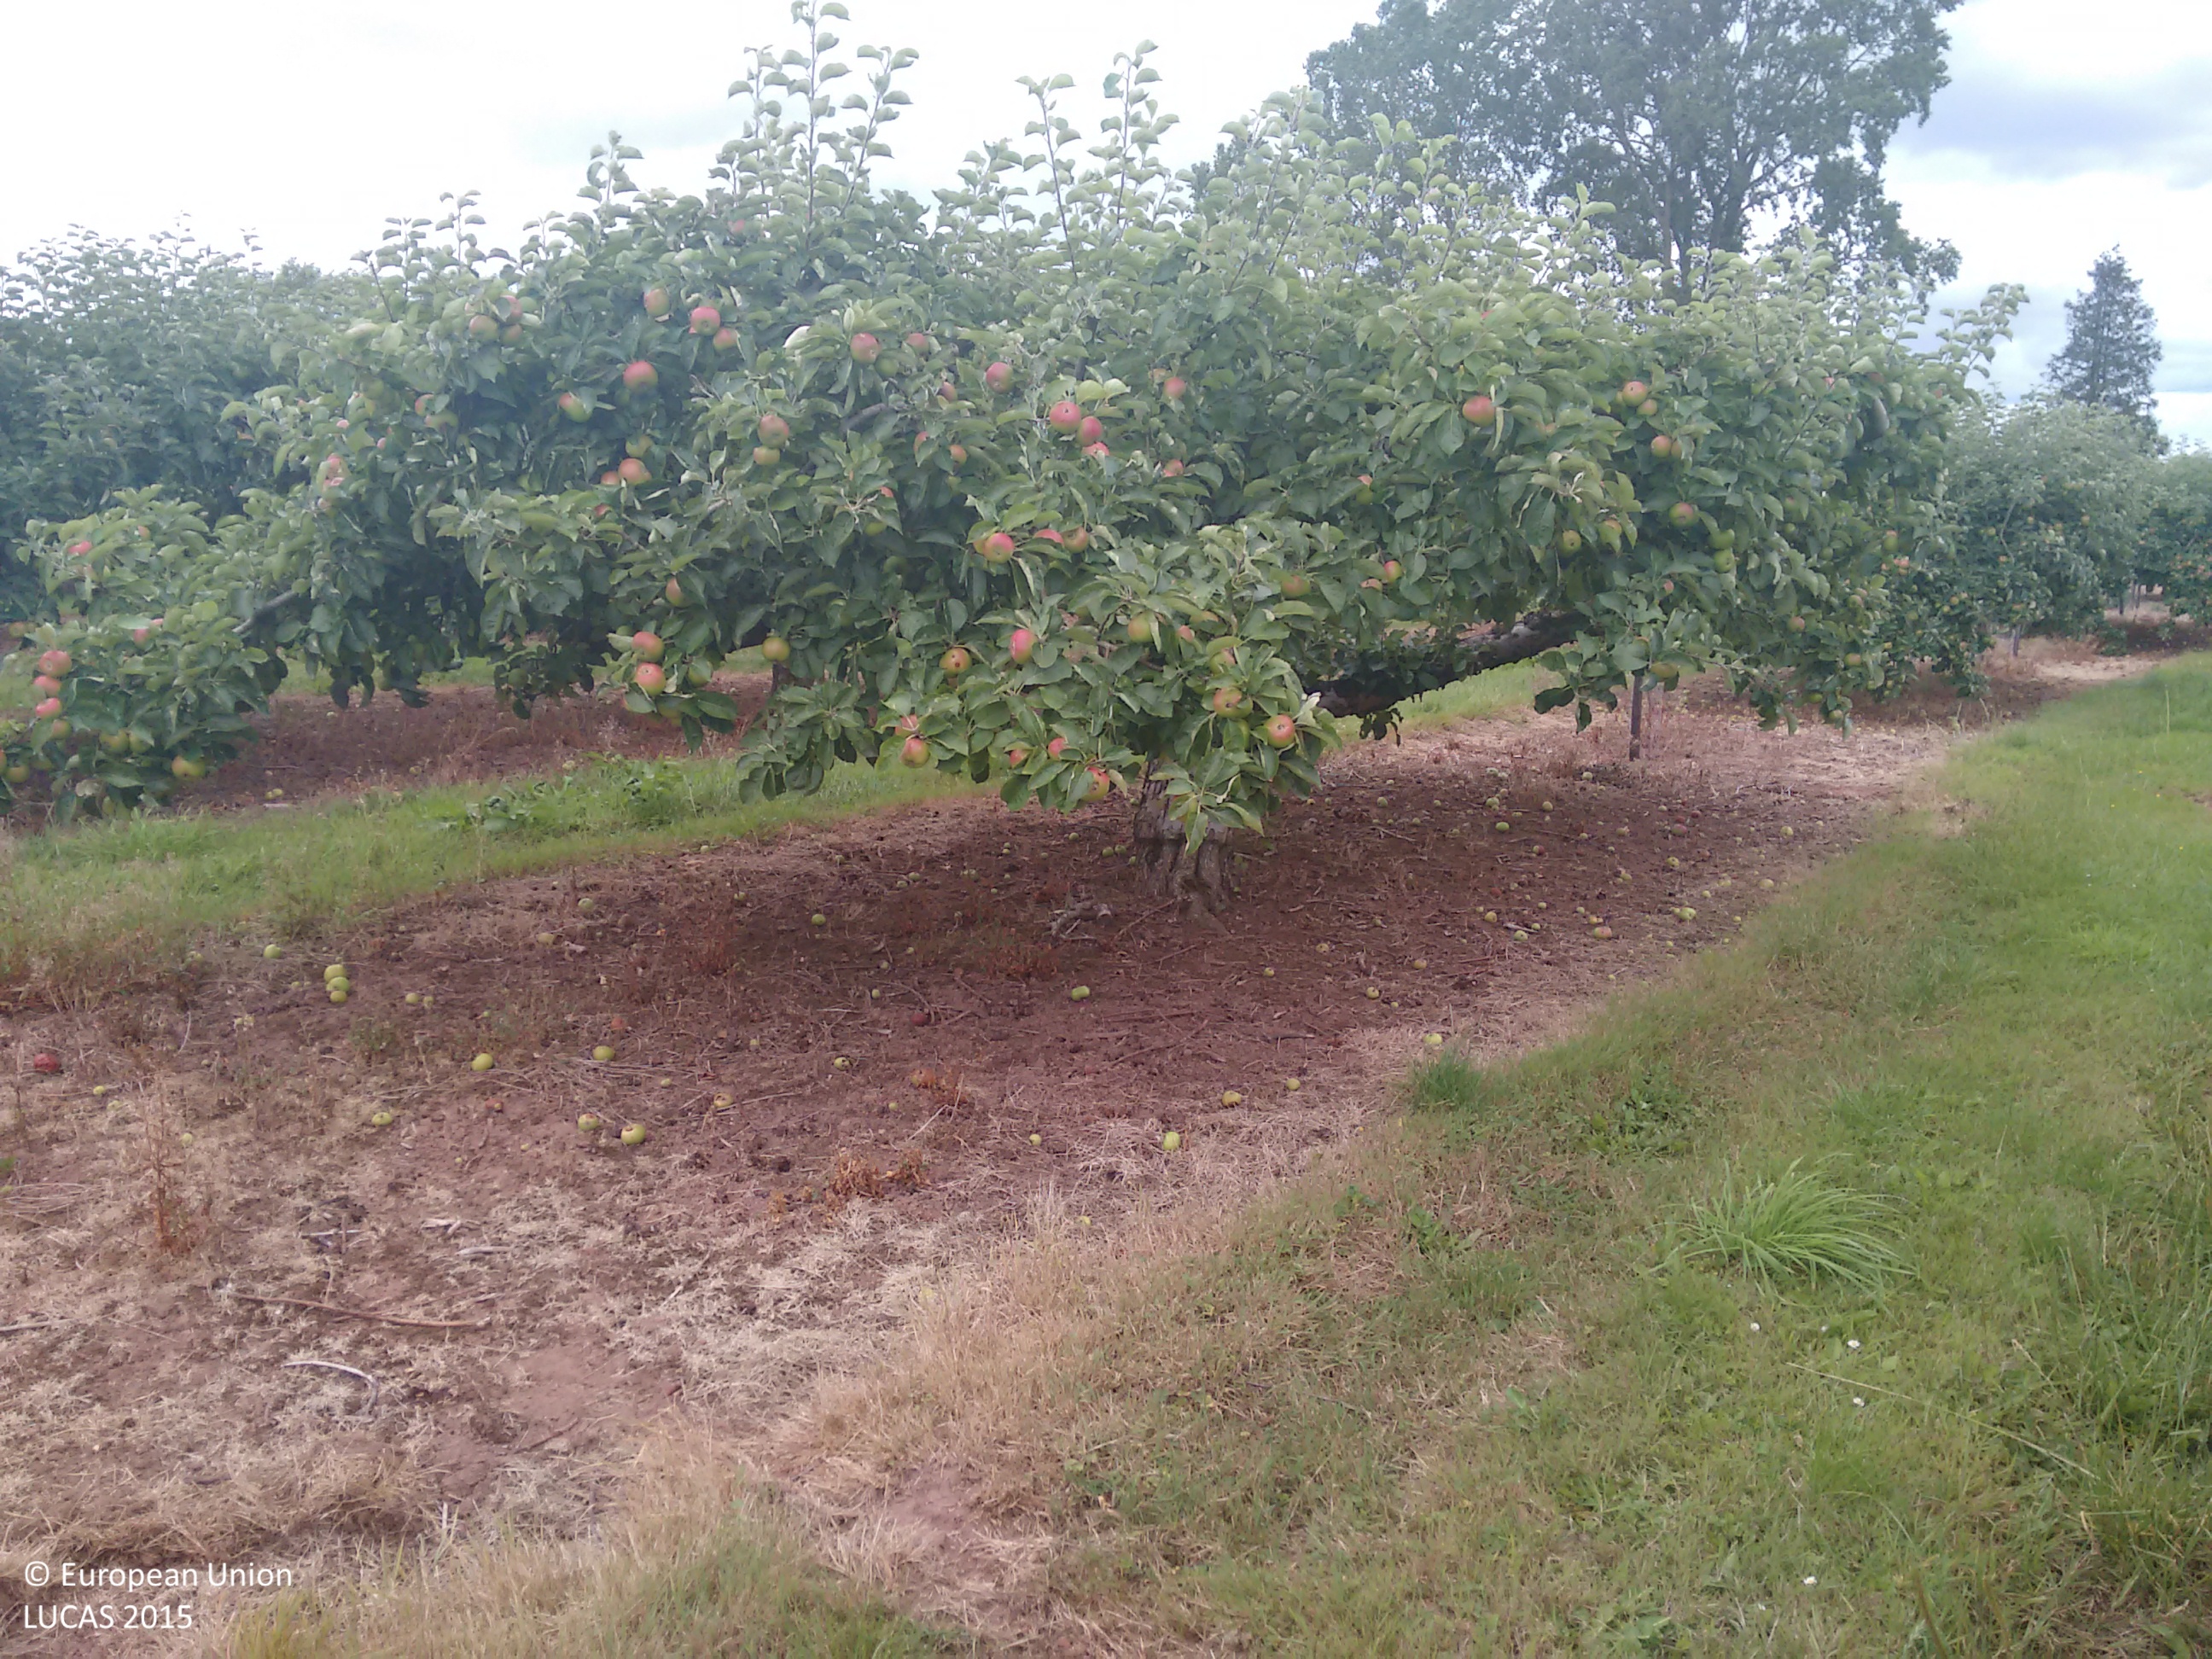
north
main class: Cropland
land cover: Apple fruit
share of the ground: > 75 %
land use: Agriculture (excluding fallow land and kitchen gardens)
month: August
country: GB
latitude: 51.9631
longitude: -2.7174
